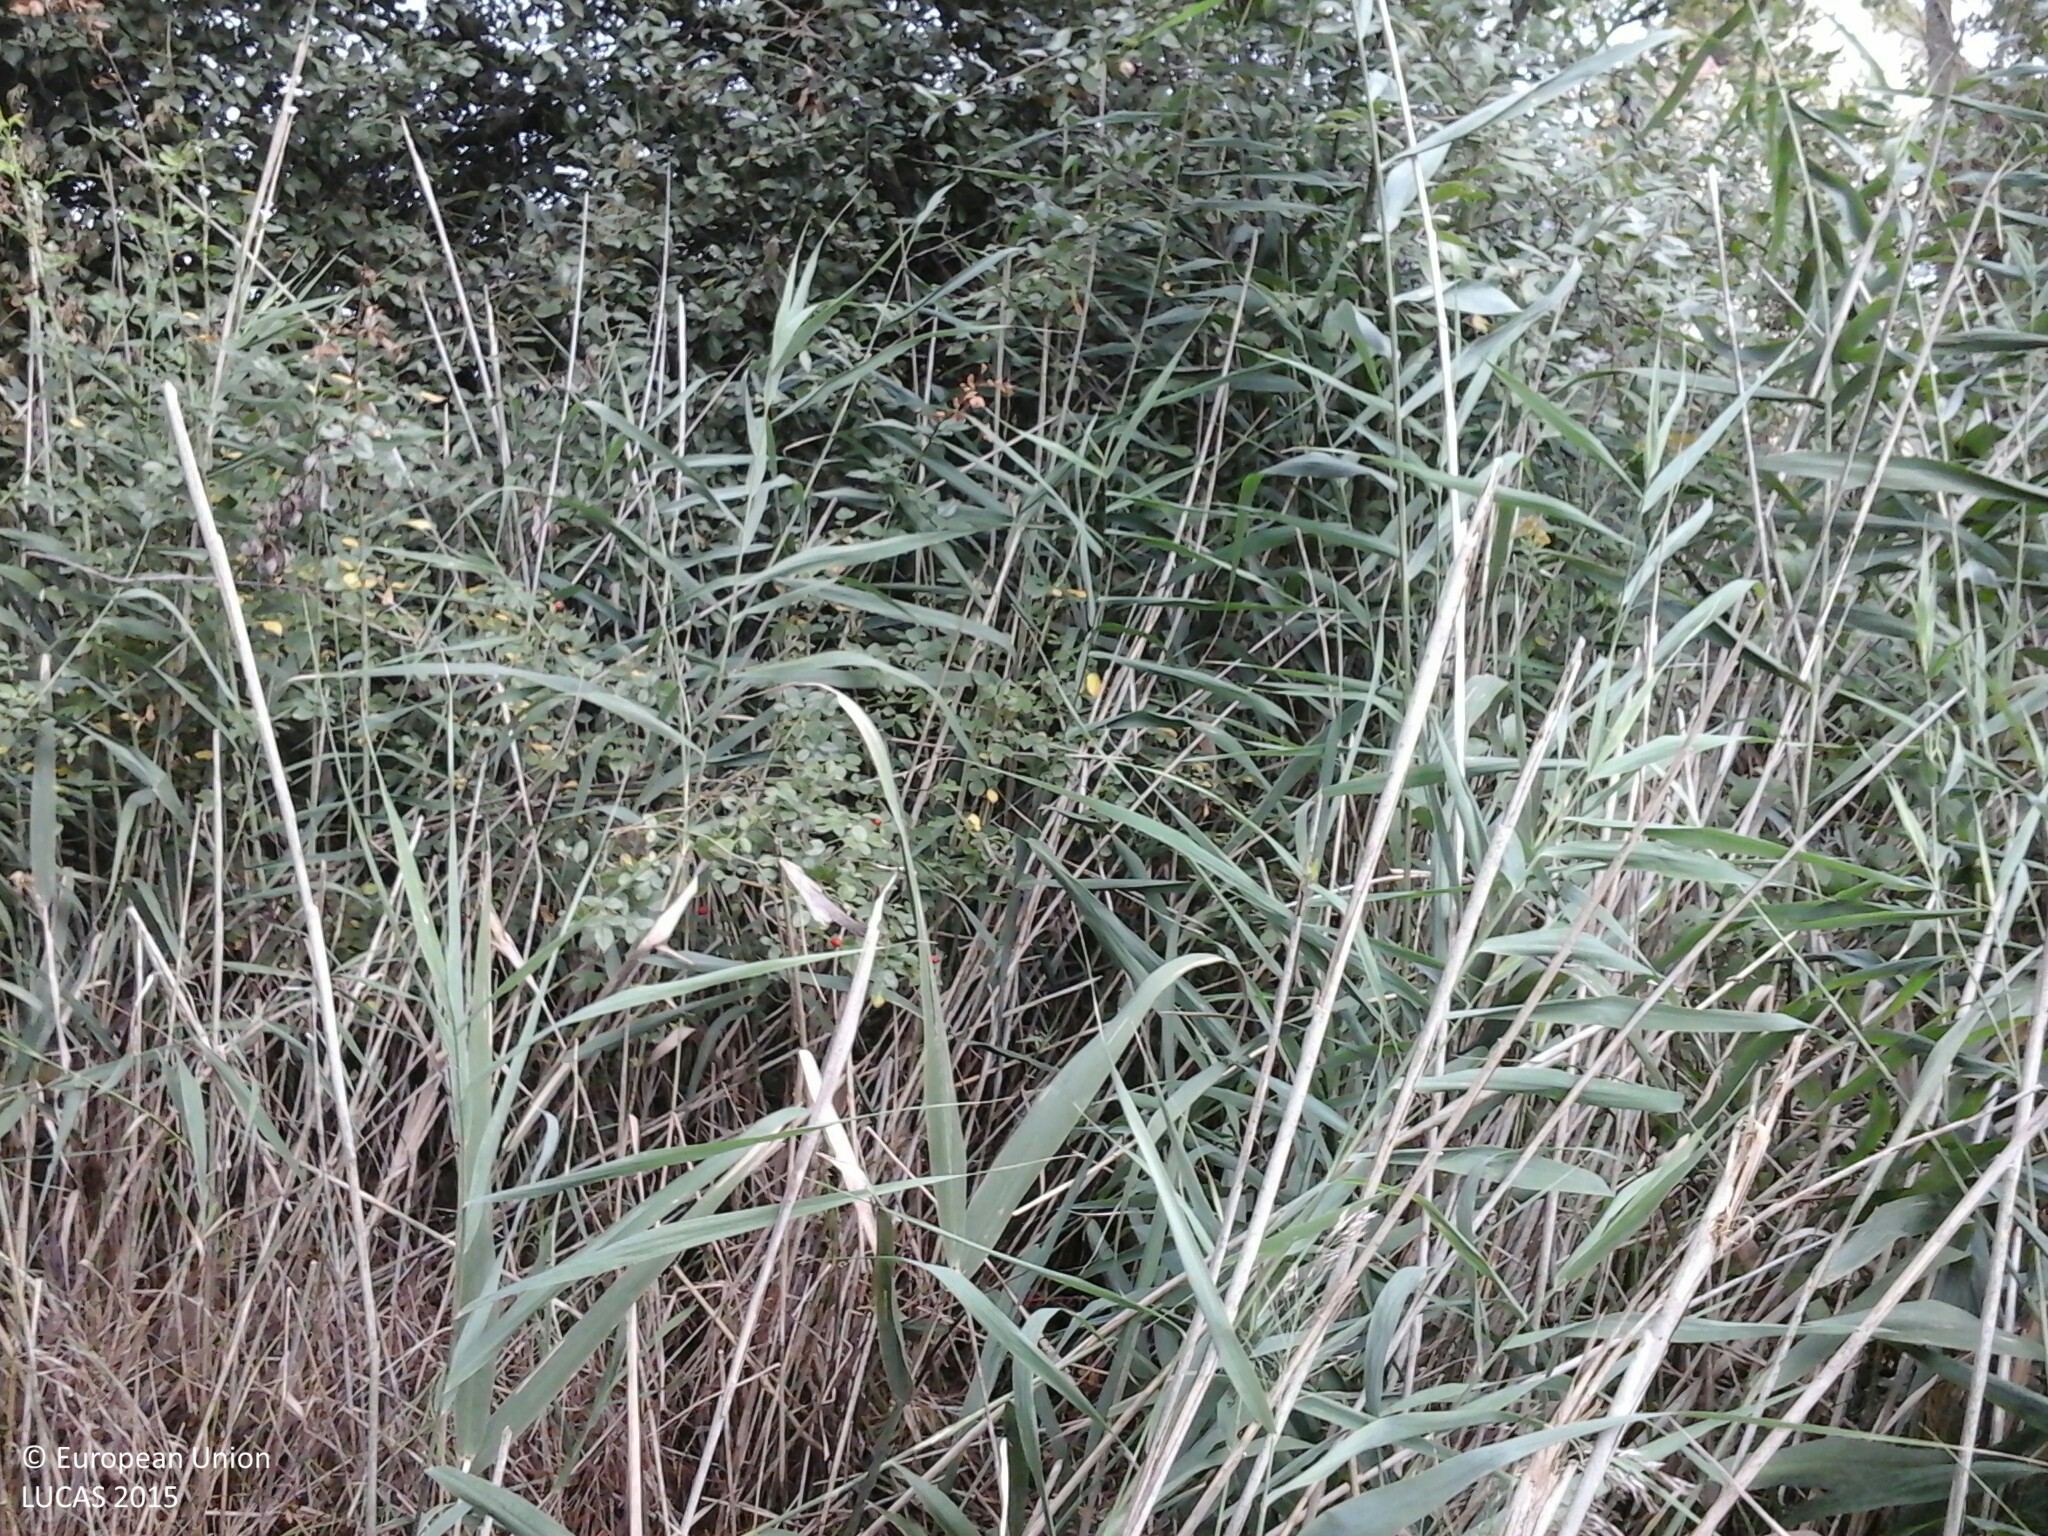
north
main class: Grassland
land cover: Grassland with sparse tree/shrub cover
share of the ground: > 75 %
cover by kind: herbaceous plants 85 %, shrubs 10 %, broadleaved forest trees 5 %
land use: Semi-natural and natural areas not in use
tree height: > 5 m
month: September
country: HU
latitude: 47.9835
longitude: 19.8203
